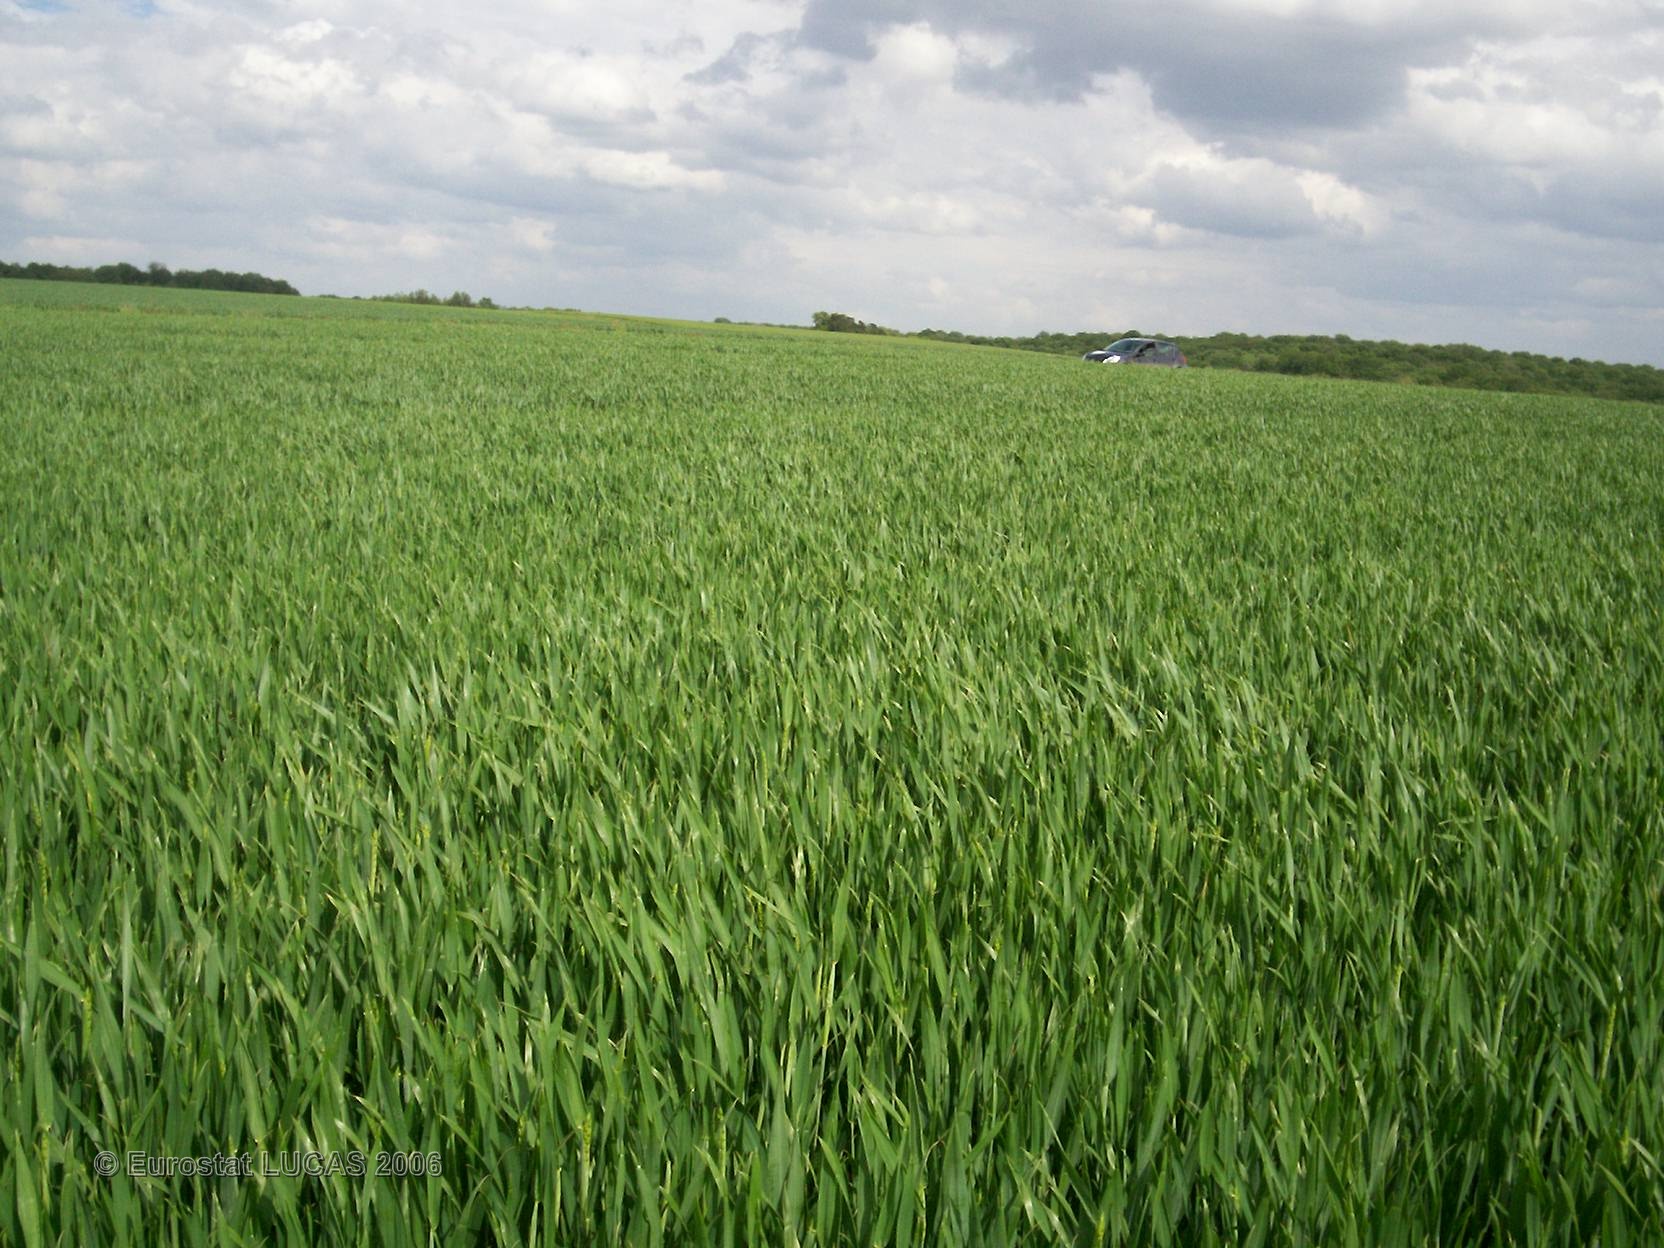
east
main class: Cropland
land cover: Common wheat
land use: Agriculture (excluding fallow land and kitchen gardens)
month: May
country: FR
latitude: 48.3916
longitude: 4.4738
